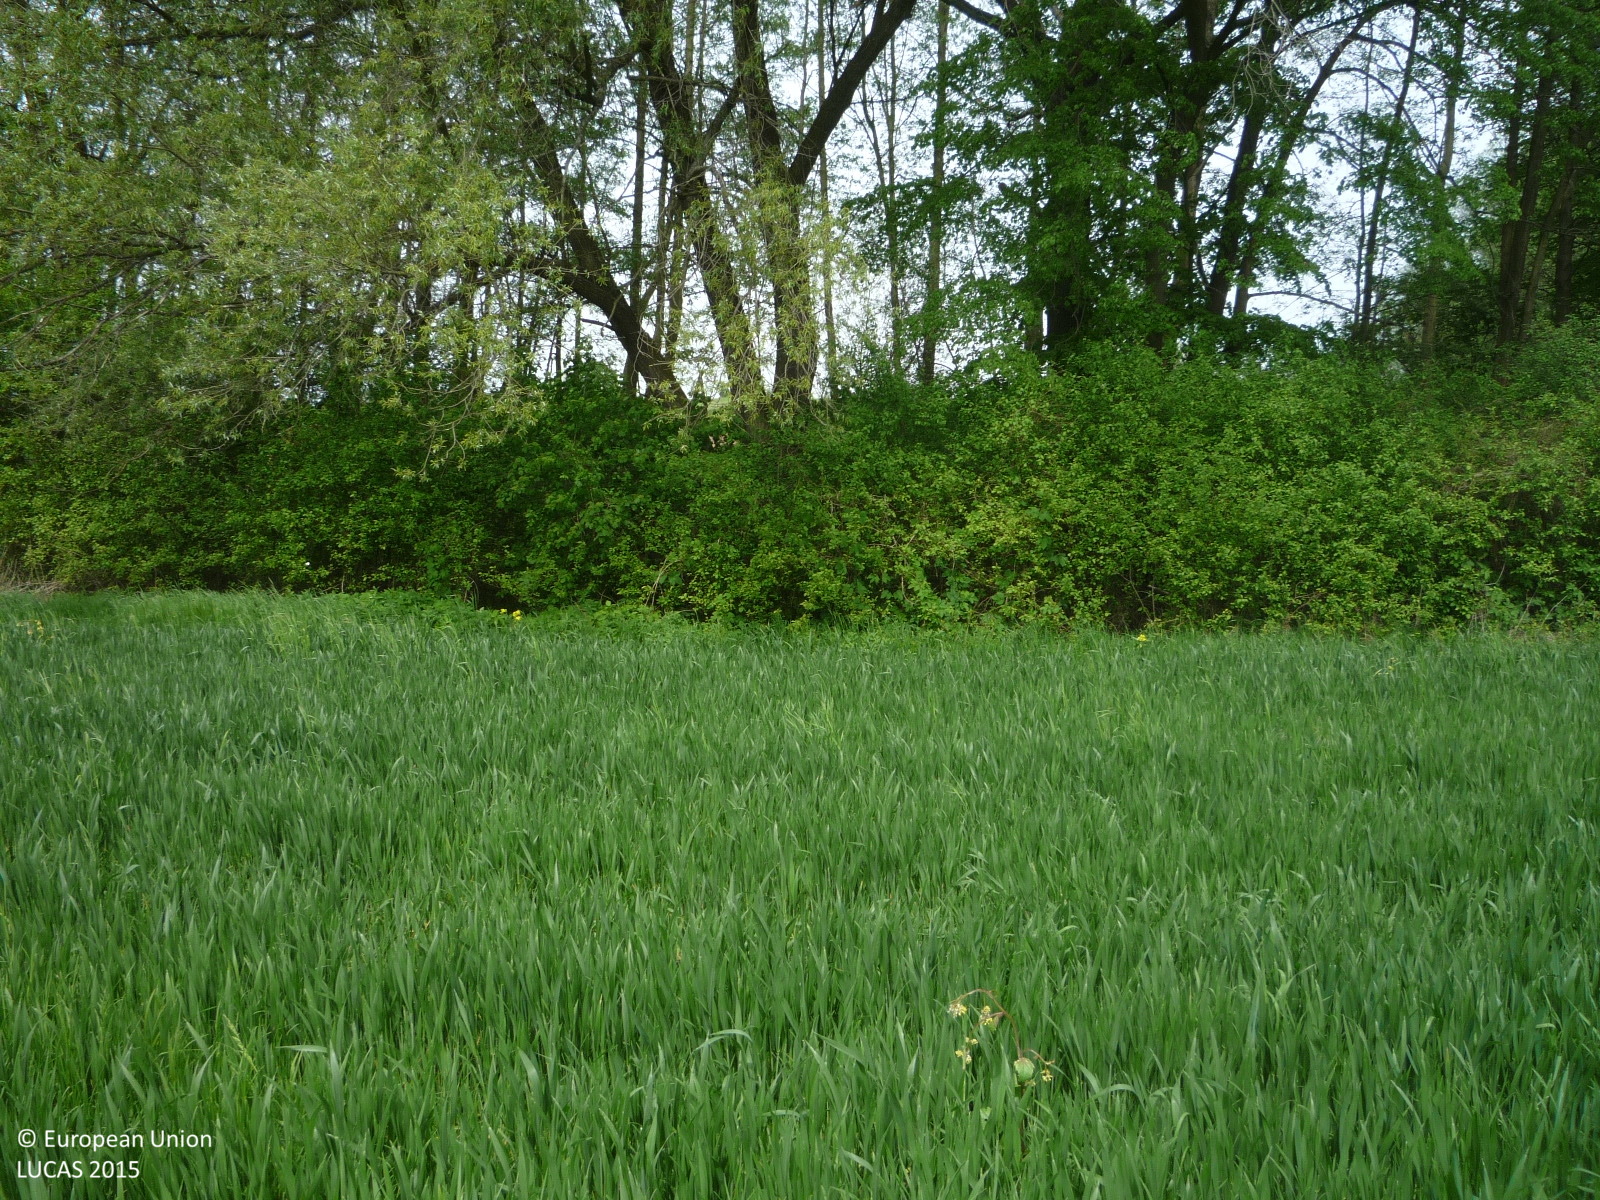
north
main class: Cropland
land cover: Common wheat
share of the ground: > 75 %
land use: Agriculture (excluding fallow land and kitchen gardens)
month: May
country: CZ
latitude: 50.3067
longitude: 14.6214
